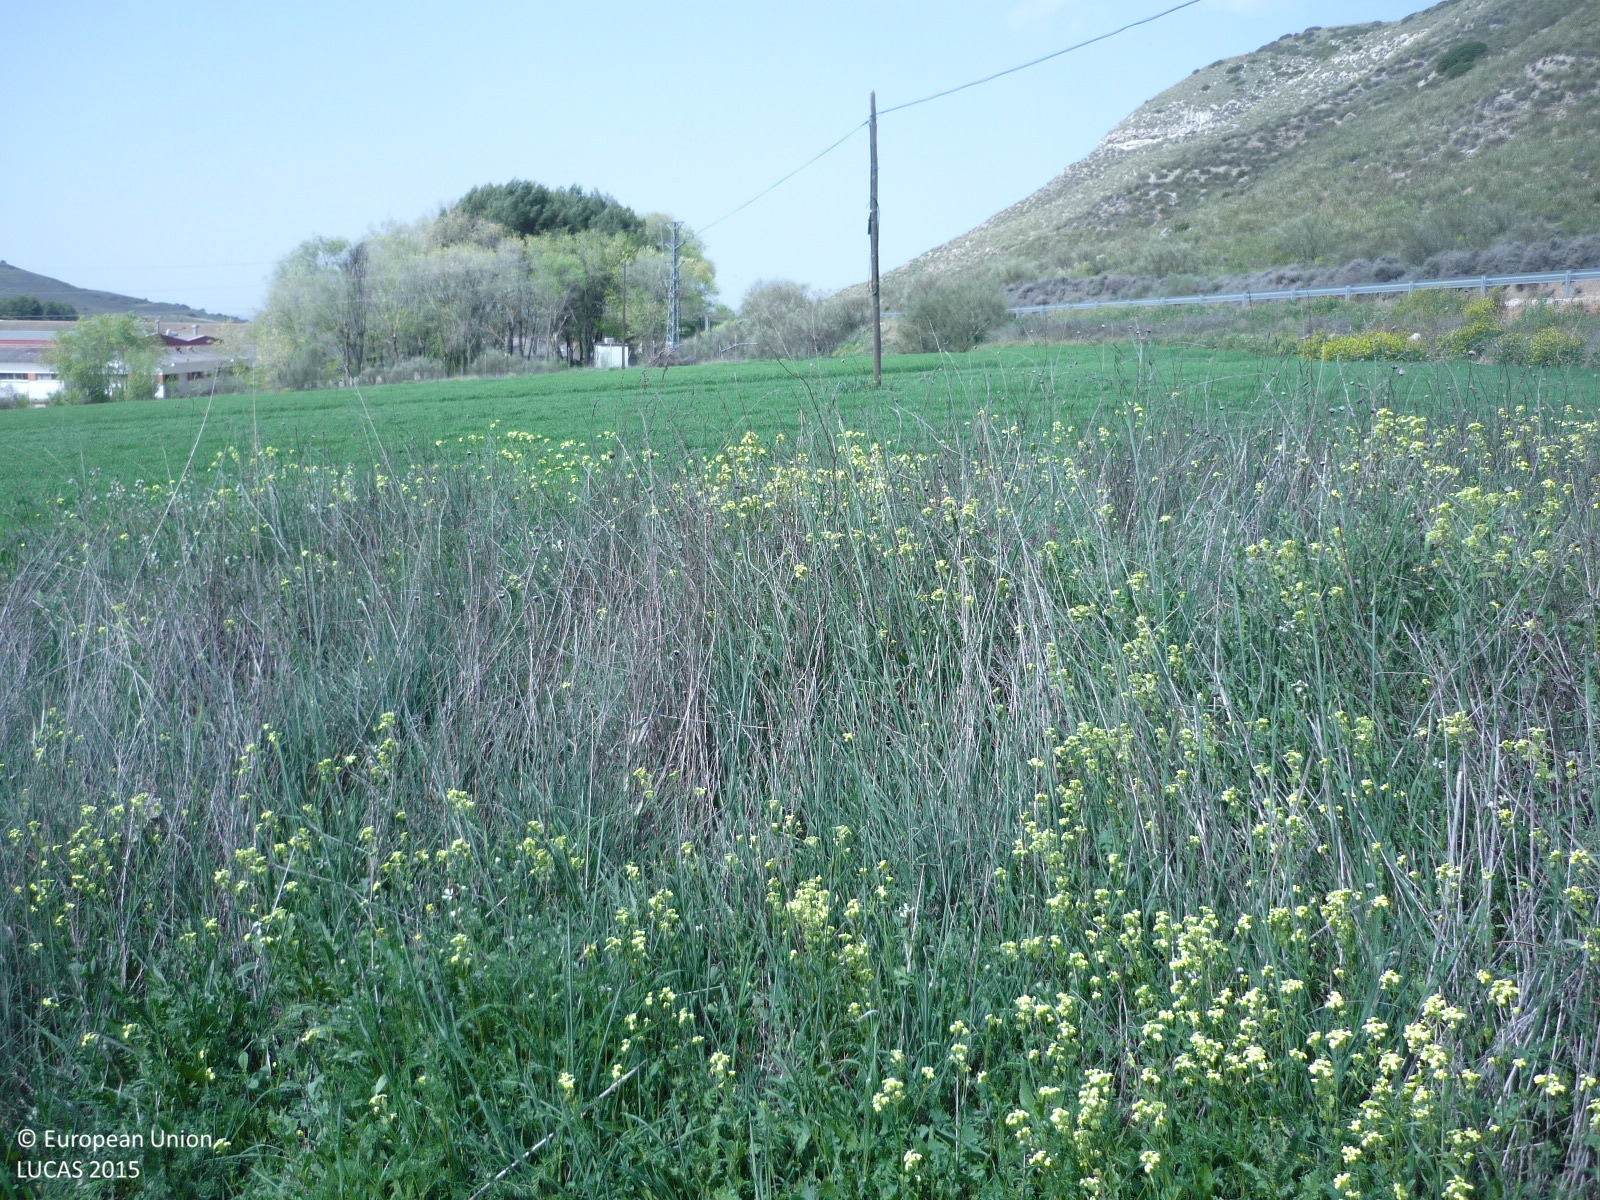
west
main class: Cropland
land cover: Barley
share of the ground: 10 - 25 %
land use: Agriculture (excluding fallow land and kitchen gardens)
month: April
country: ES
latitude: 40.4172
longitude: -3.3146
